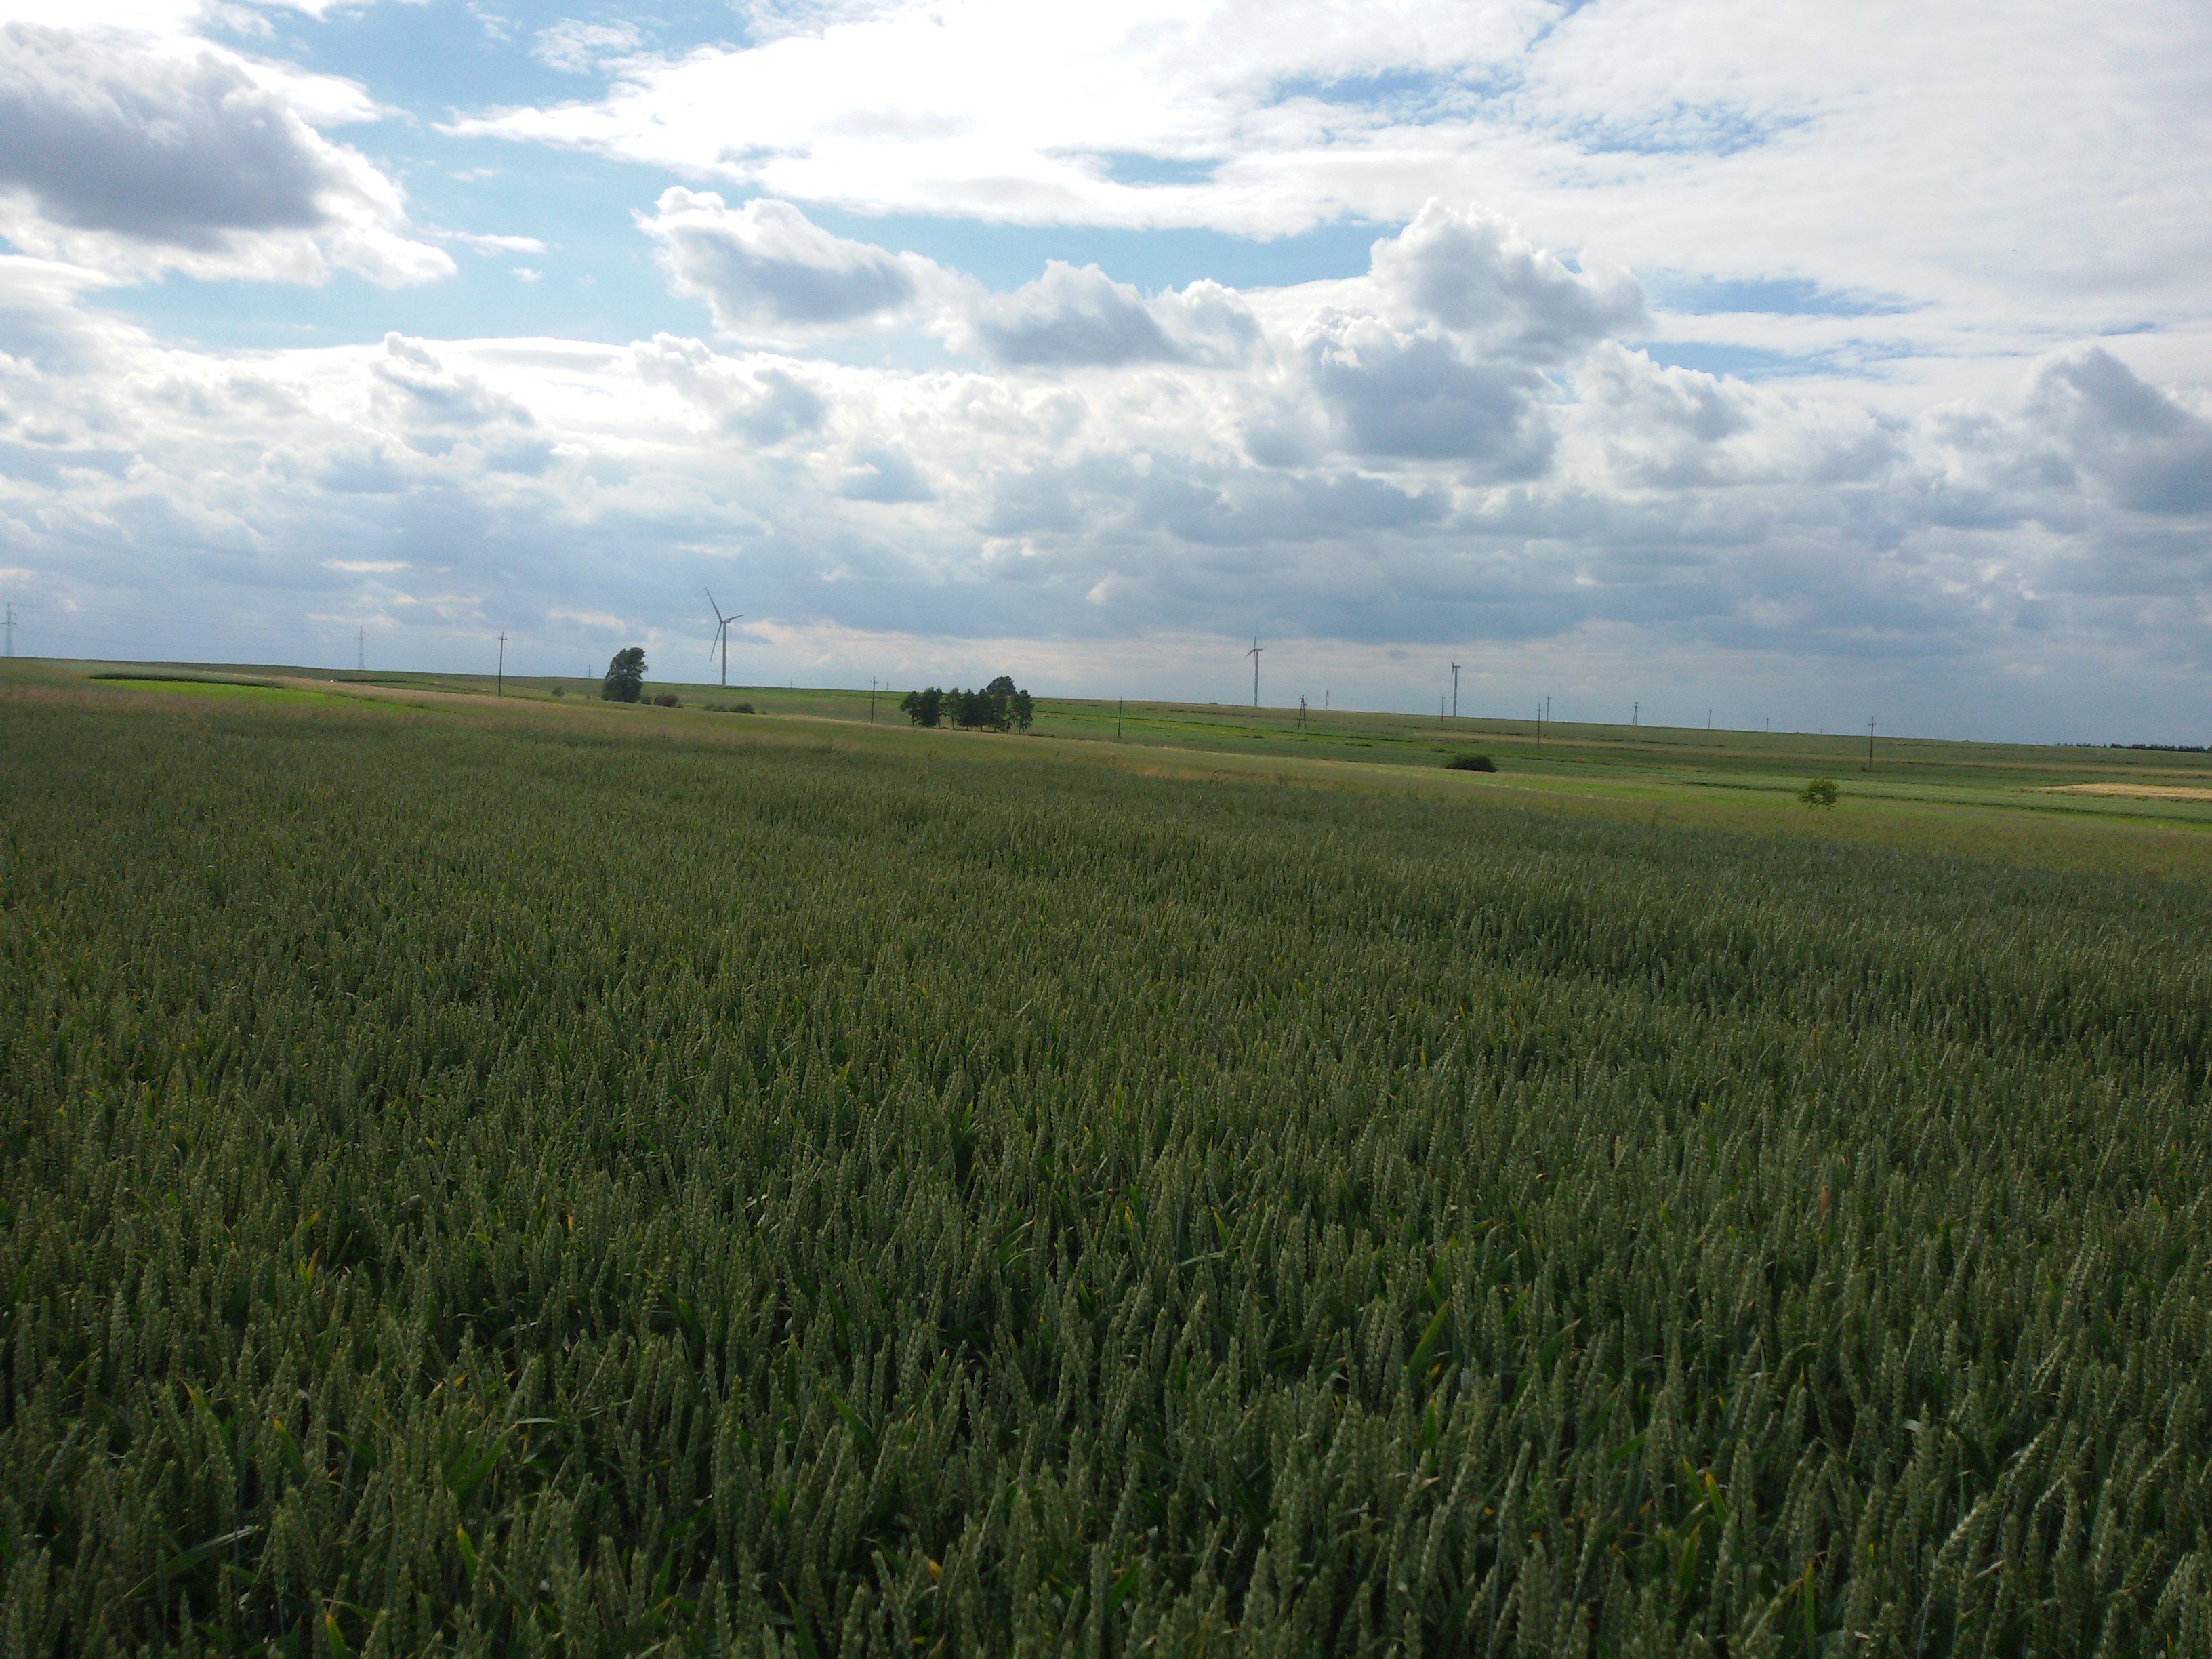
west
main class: Cropland
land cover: Common wheat
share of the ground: > 75 %
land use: Agriculture (excluding fallow land and kitchen gardens)
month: June
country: PL
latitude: 50.0566
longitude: 22.3402
